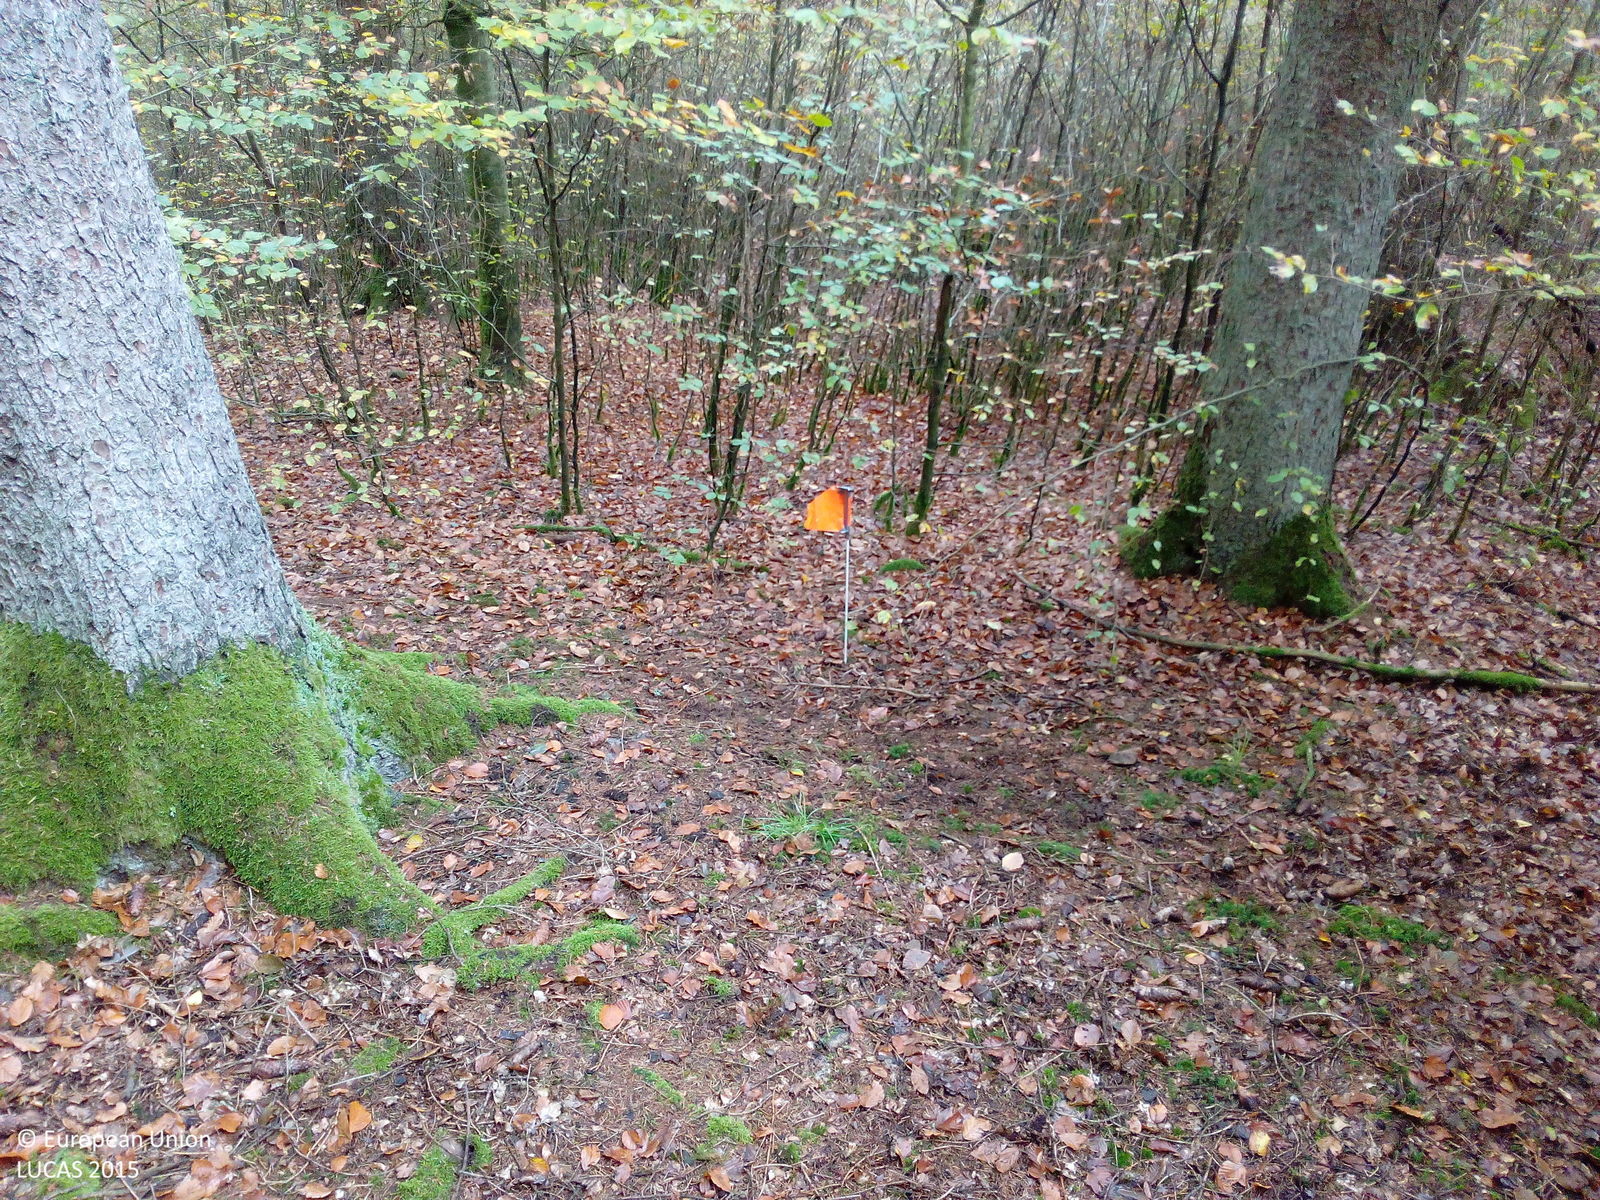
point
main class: Woodland
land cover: Spruce dominated mixed woodland
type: hemiboreal forest and nemoral coniferous forest and mixed broadleaved-coniferous forest
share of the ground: 50 - 75 %
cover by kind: broadleaved forest trees 40 %, coniferous forest trees 25 %, lichens and mosses 15 %, unconsolidated bare surface 10 %, shrubs 5 %, herbaceous plants 5 %
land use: Forestry
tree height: > 5 m
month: October
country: DE
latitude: 50.2554
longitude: 9.5934
